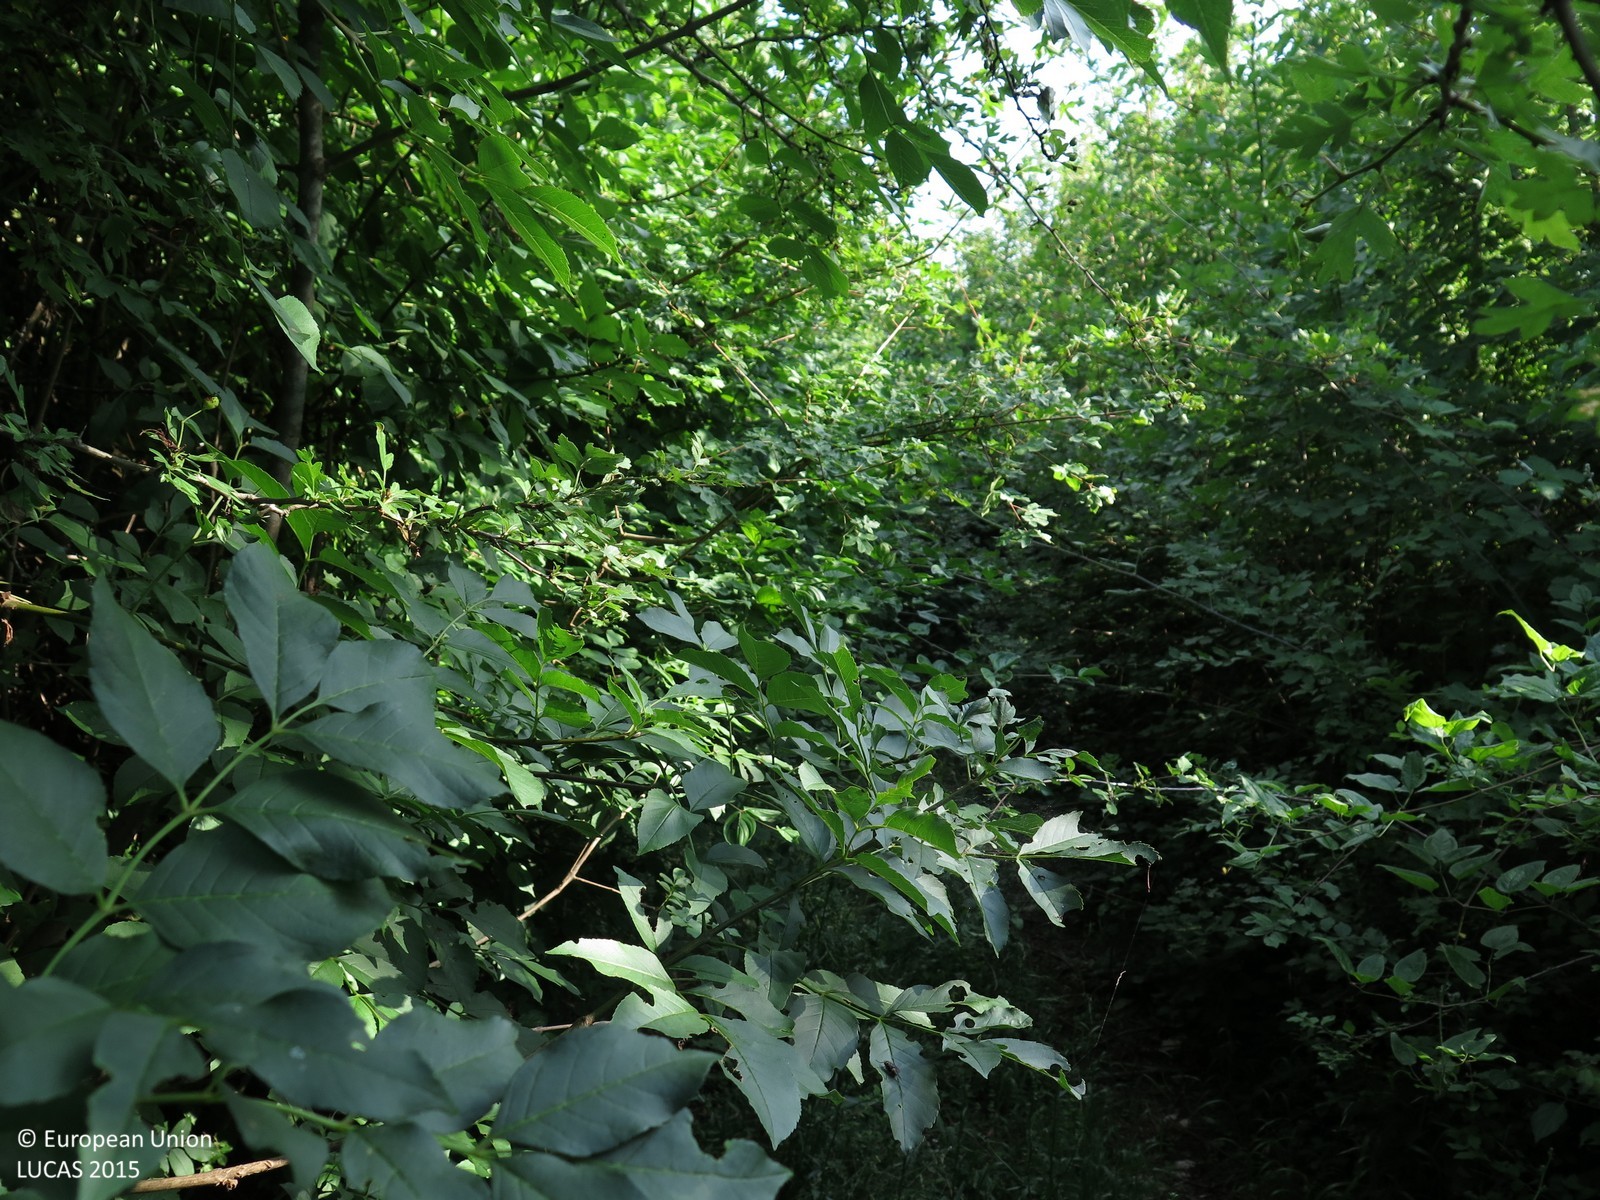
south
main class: Woodland
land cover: Broadleaved woodland
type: mesophytic deciduous forest
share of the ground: > 75 %
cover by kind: broadleaved forest trees 95 %, shrubs 5 %
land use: Semi-natural and natural areas not in use
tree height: > 5 m
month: June
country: HR
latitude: 45.1456
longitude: 13.8482
